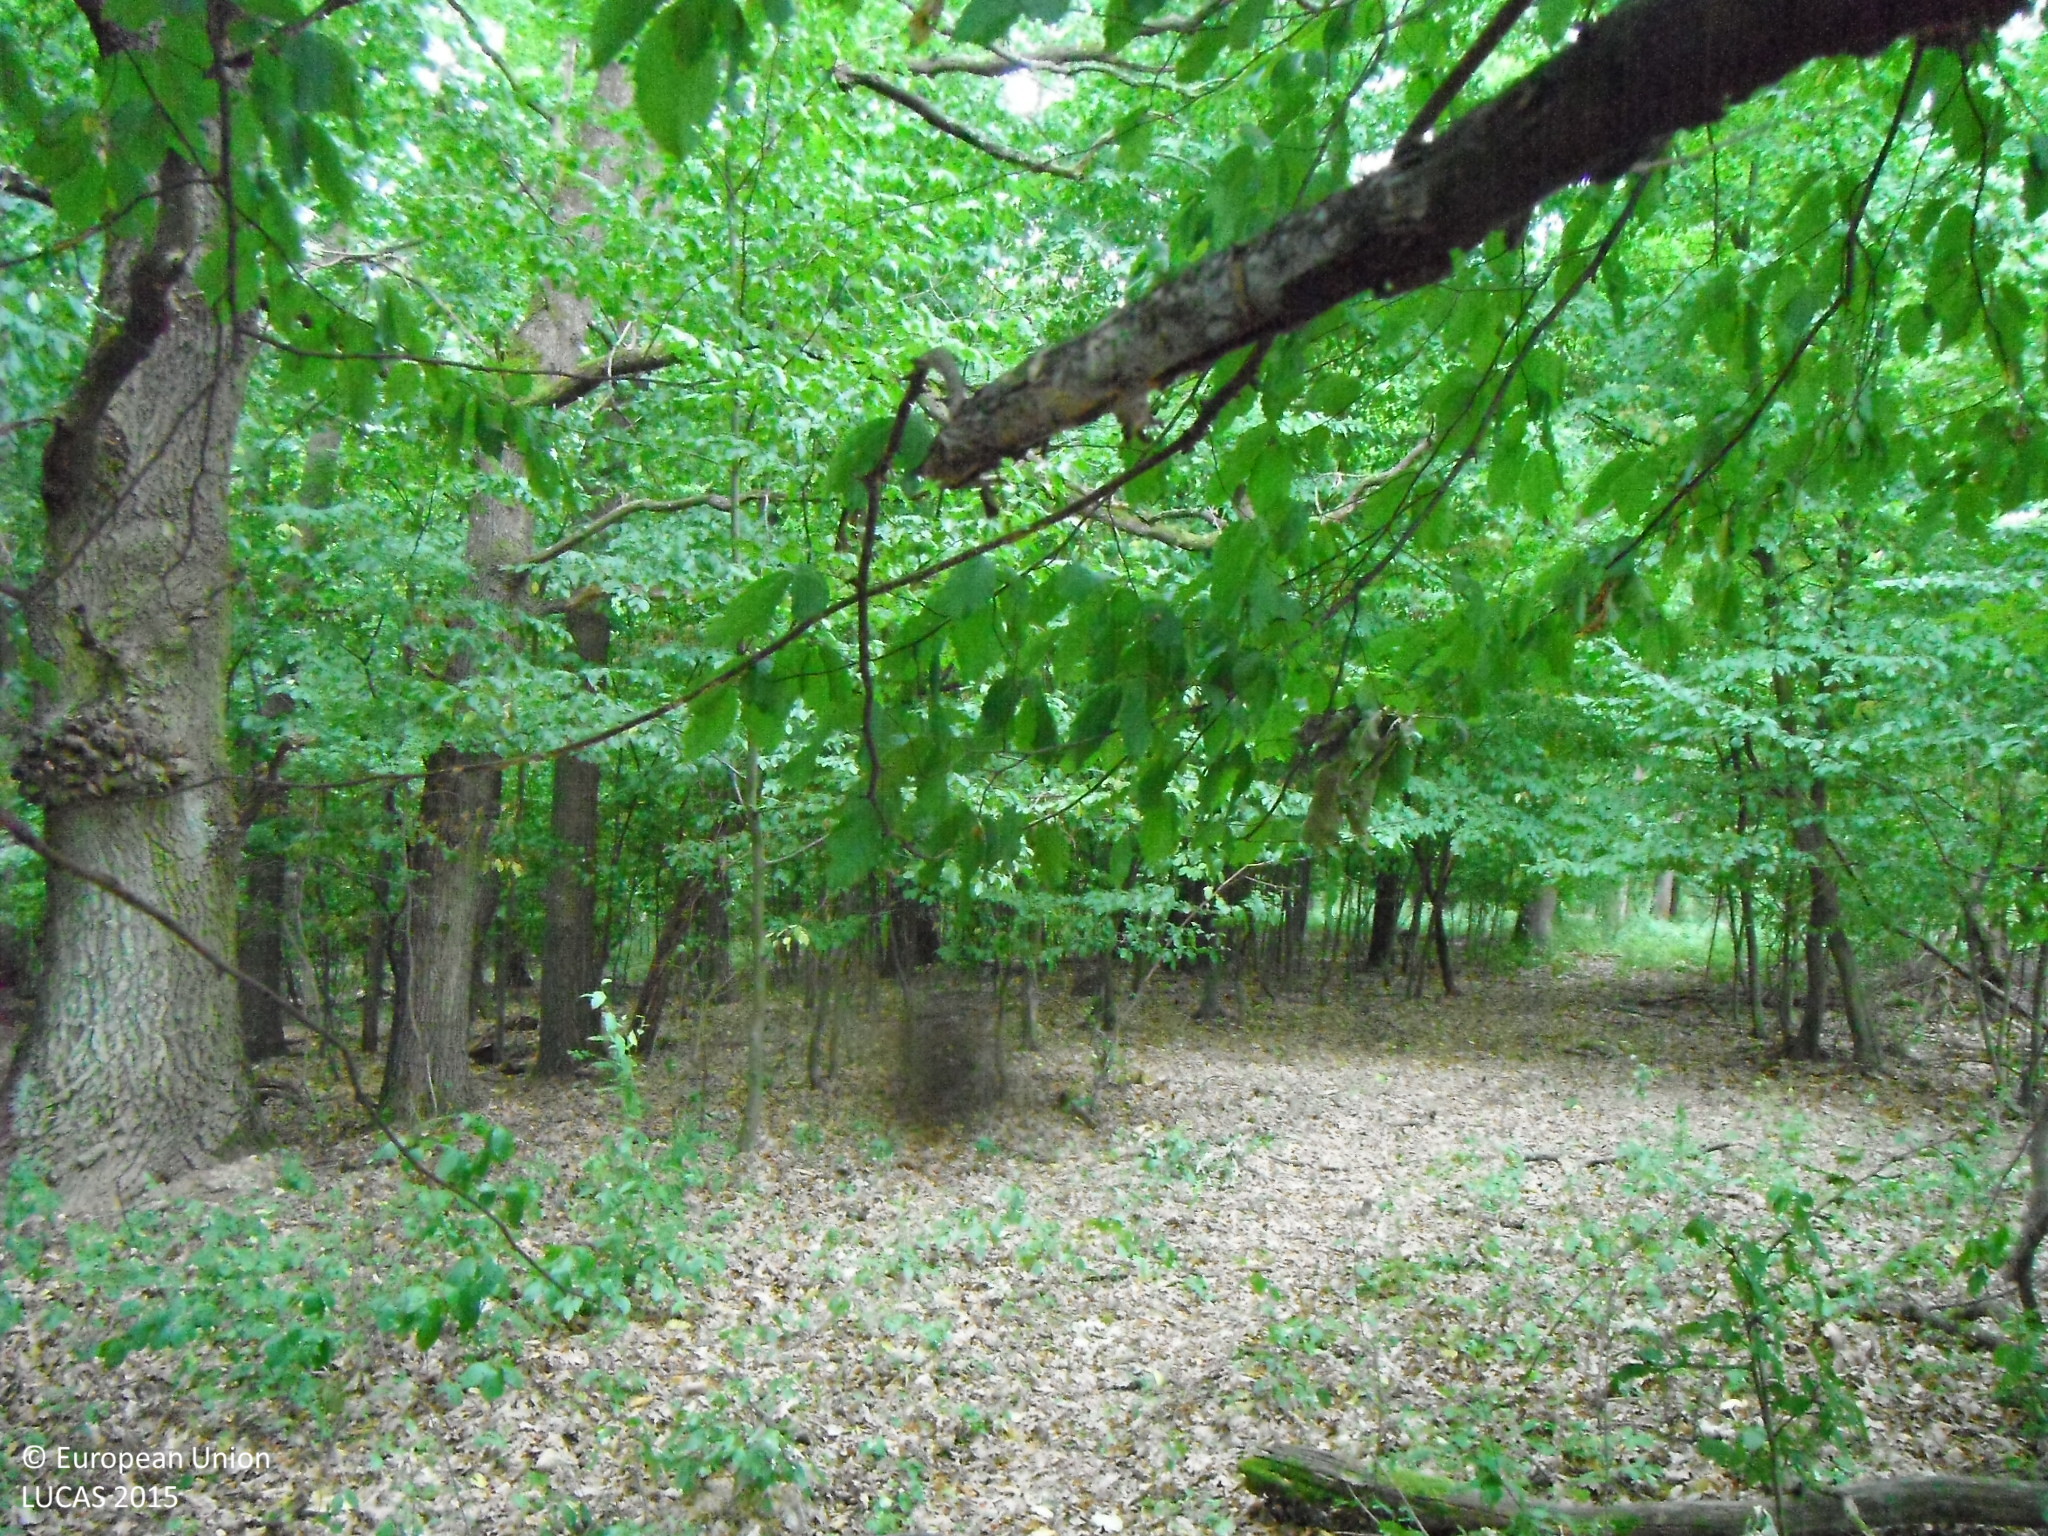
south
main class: Woodland
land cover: Broadleaved woodland
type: mesophytic deciduous forest
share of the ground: > 75 %
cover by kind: broadleaved forest trees 100 %
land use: Forestry
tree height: > 5 m
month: July
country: SK
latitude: 48.3300
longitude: 19.9972
